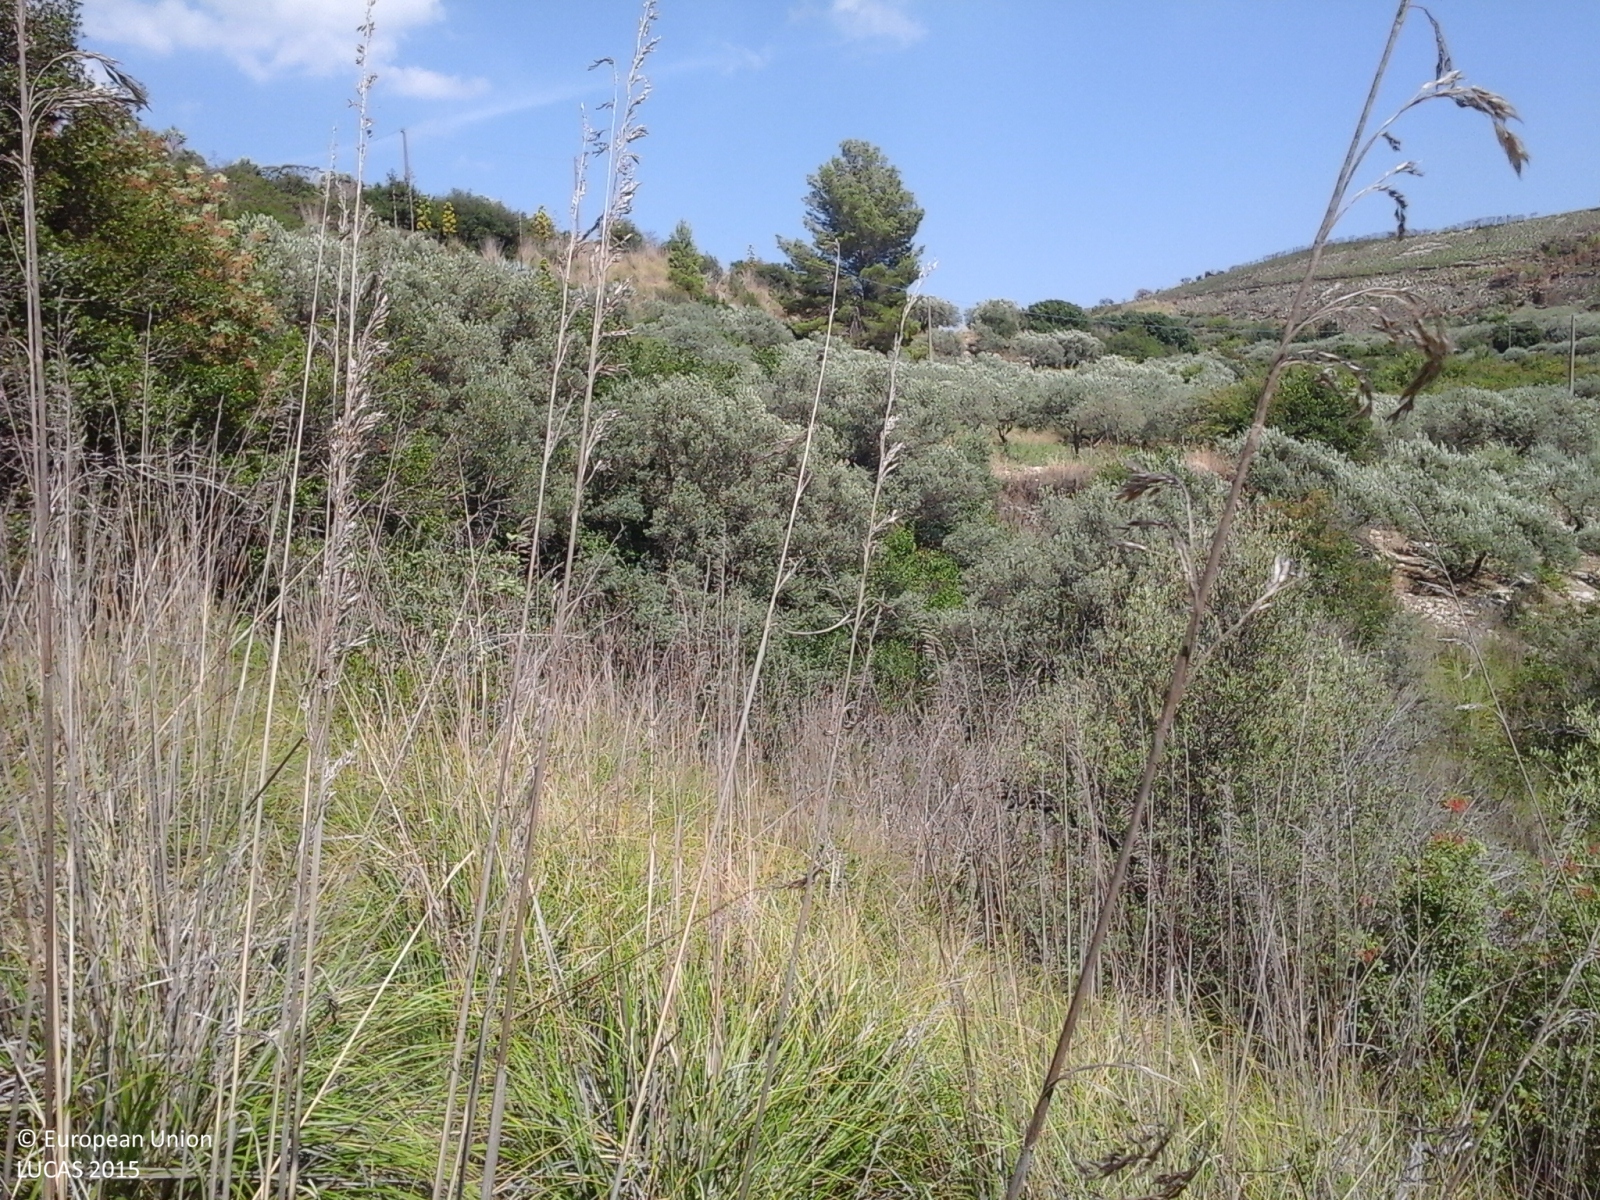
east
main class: Shrubland
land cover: Shrubland with sparse tree cover
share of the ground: > 75 %
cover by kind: shrubs 90 %, coniferous forest trees 5 %, herbaceous plants 5 %
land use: Semi-natural and natural areas not in use
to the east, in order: Shrubland with sparse tree cover; Olive groves; Electric lines; Olive groves; Tracks; Shrubland with sparse tree cover; Grass margins; Paved roads, cycling and walking lanes; Grass margins; Dry stone walls; Shrubland without tree cover; Dry stone walls; Olive groves
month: July
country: IT
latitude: 37.1492
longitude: 14.8829
